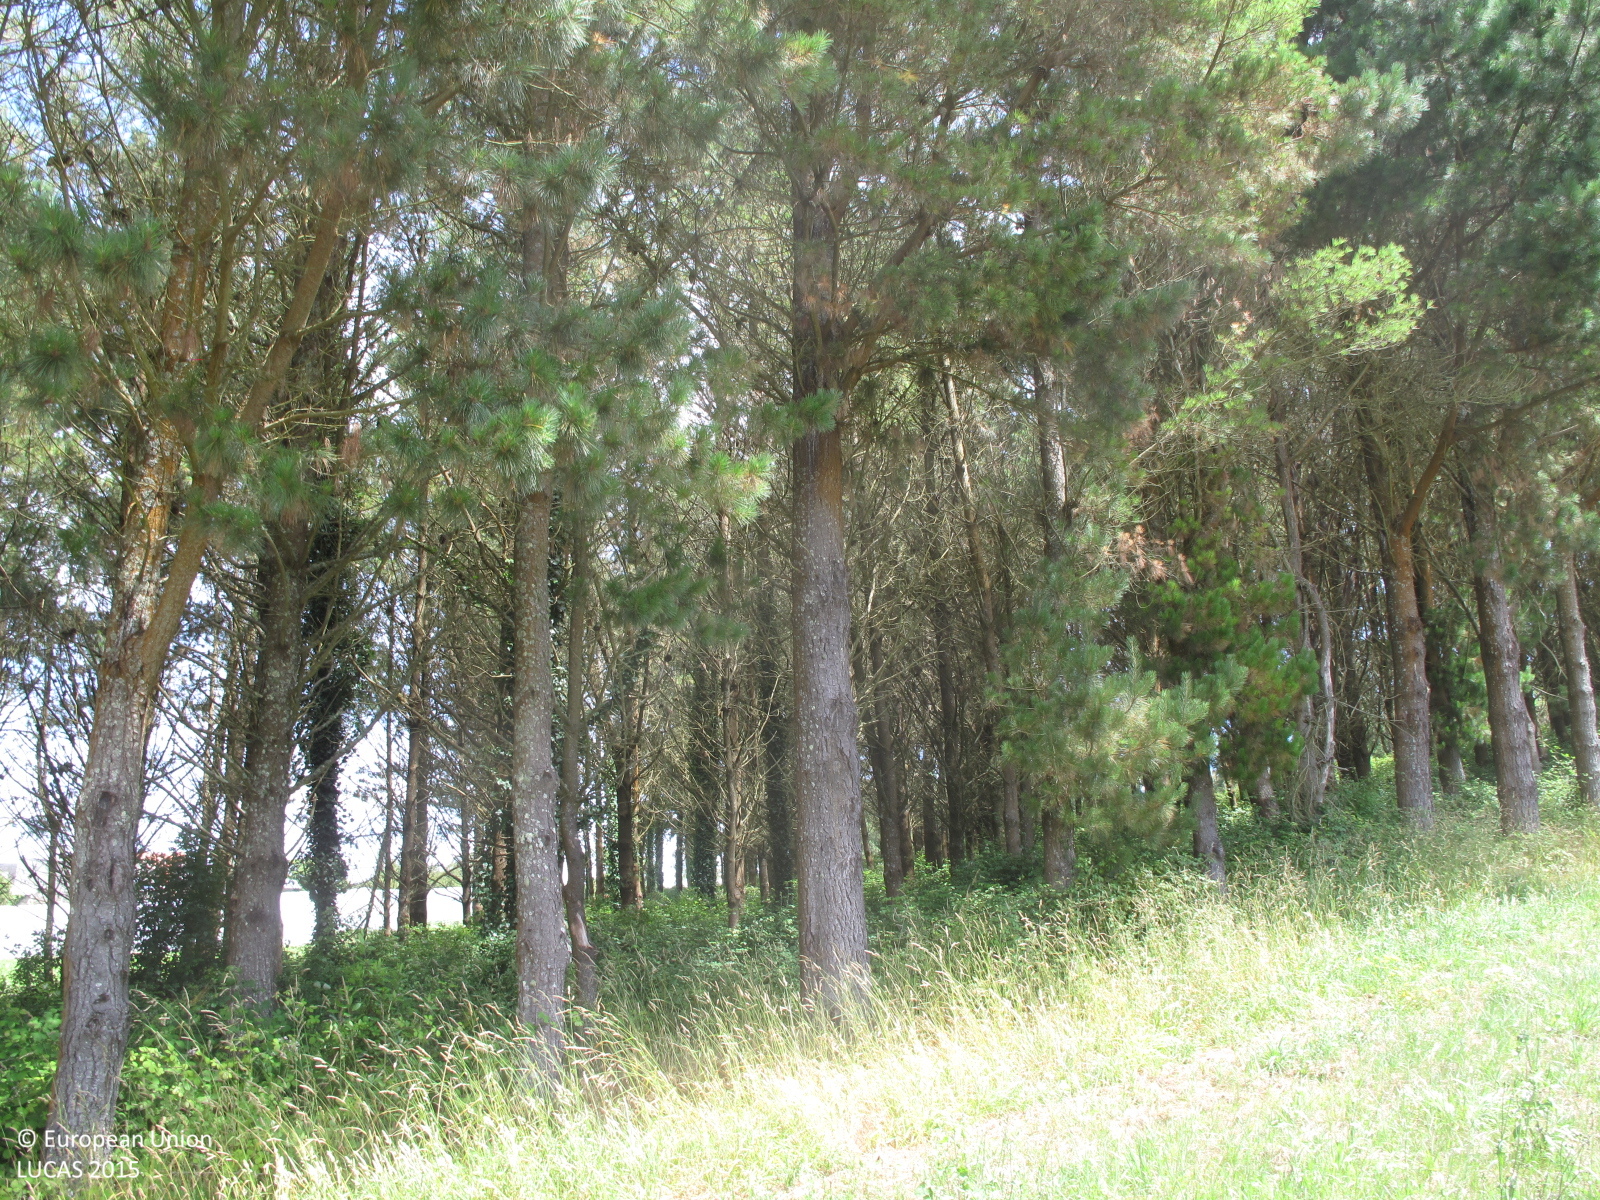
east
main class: Grassland
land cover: Grassland without tree/shrub cover
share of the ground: 50 - 75 %
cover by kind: herbaceous plants 70 %, unconsolidated bare surface 30 %
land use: Agriculture (excluding fallow land and kitchen gardens)
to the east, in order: Grassland without tree/shrub cover; Pine dominated coniferous woodland; Potatoes; Maize; Potatoes; Other fresh vegetables; Artificial constructions in urban areas; Apple fruit; Tracks; Groves; Grassland without tree/shrub cover; Fences; Grassland without tree/shrub cover; Fences; Maize; Other fresh vegetables
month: July
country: ES
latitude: 43.1856
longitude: -8.6034
